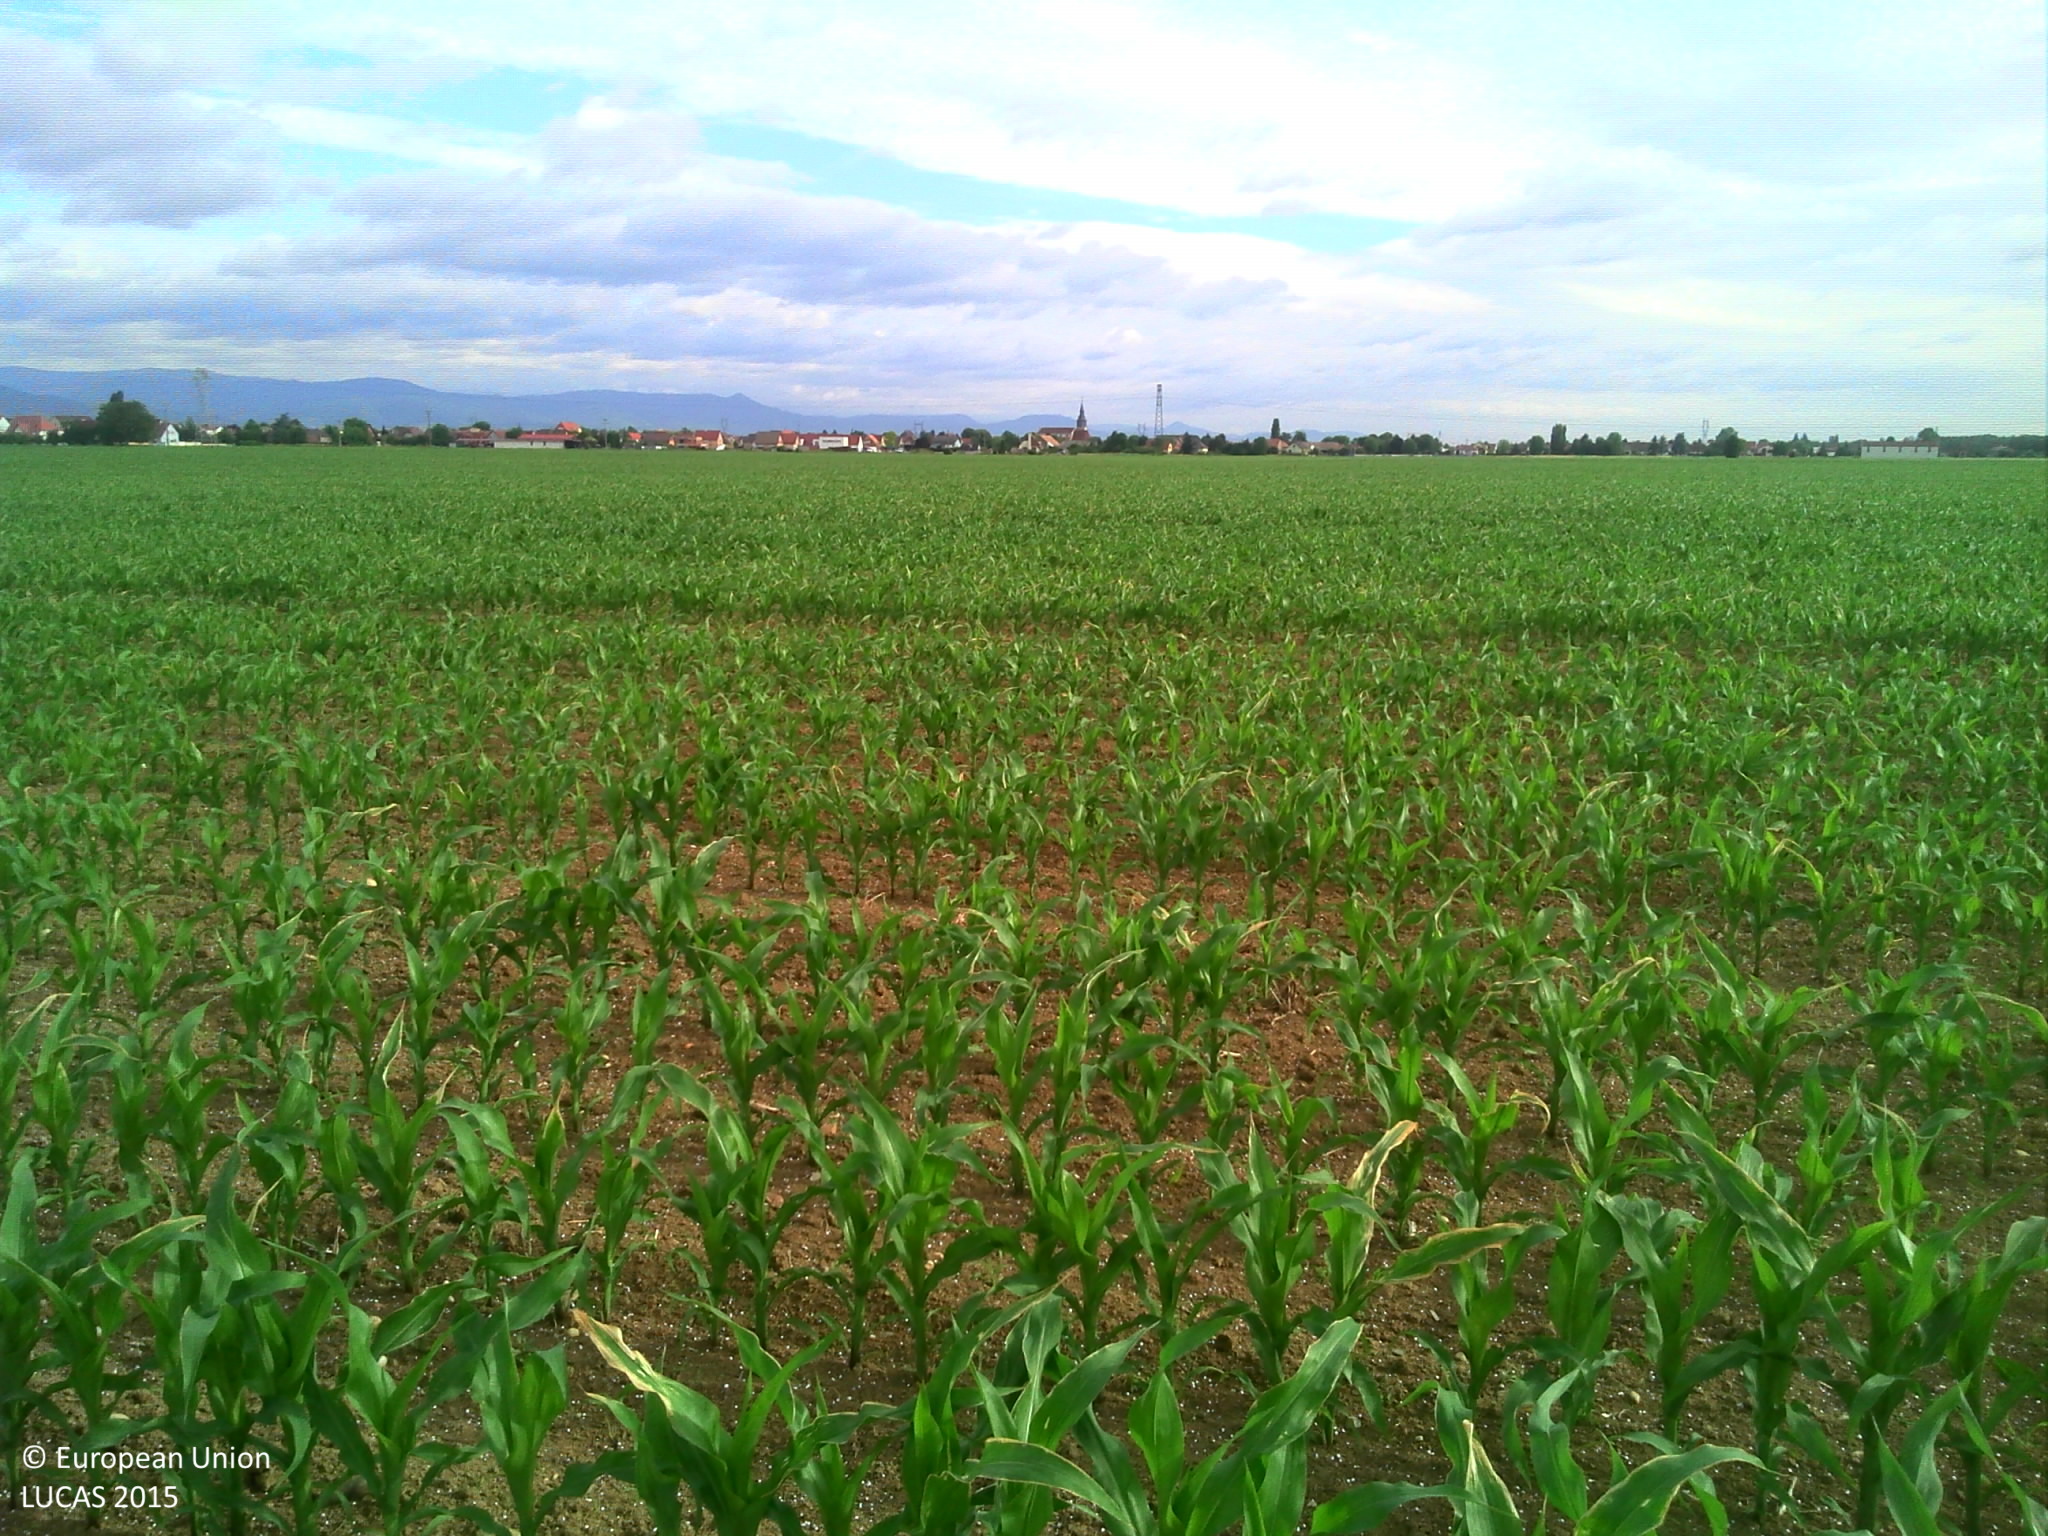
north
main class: Cropland
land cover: Maize
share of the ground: 10 - 25 %
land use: Agriculture (excluding fallow land and kitchen gardens)
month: June
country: FR
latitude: 47.9946
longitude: 7.3880
